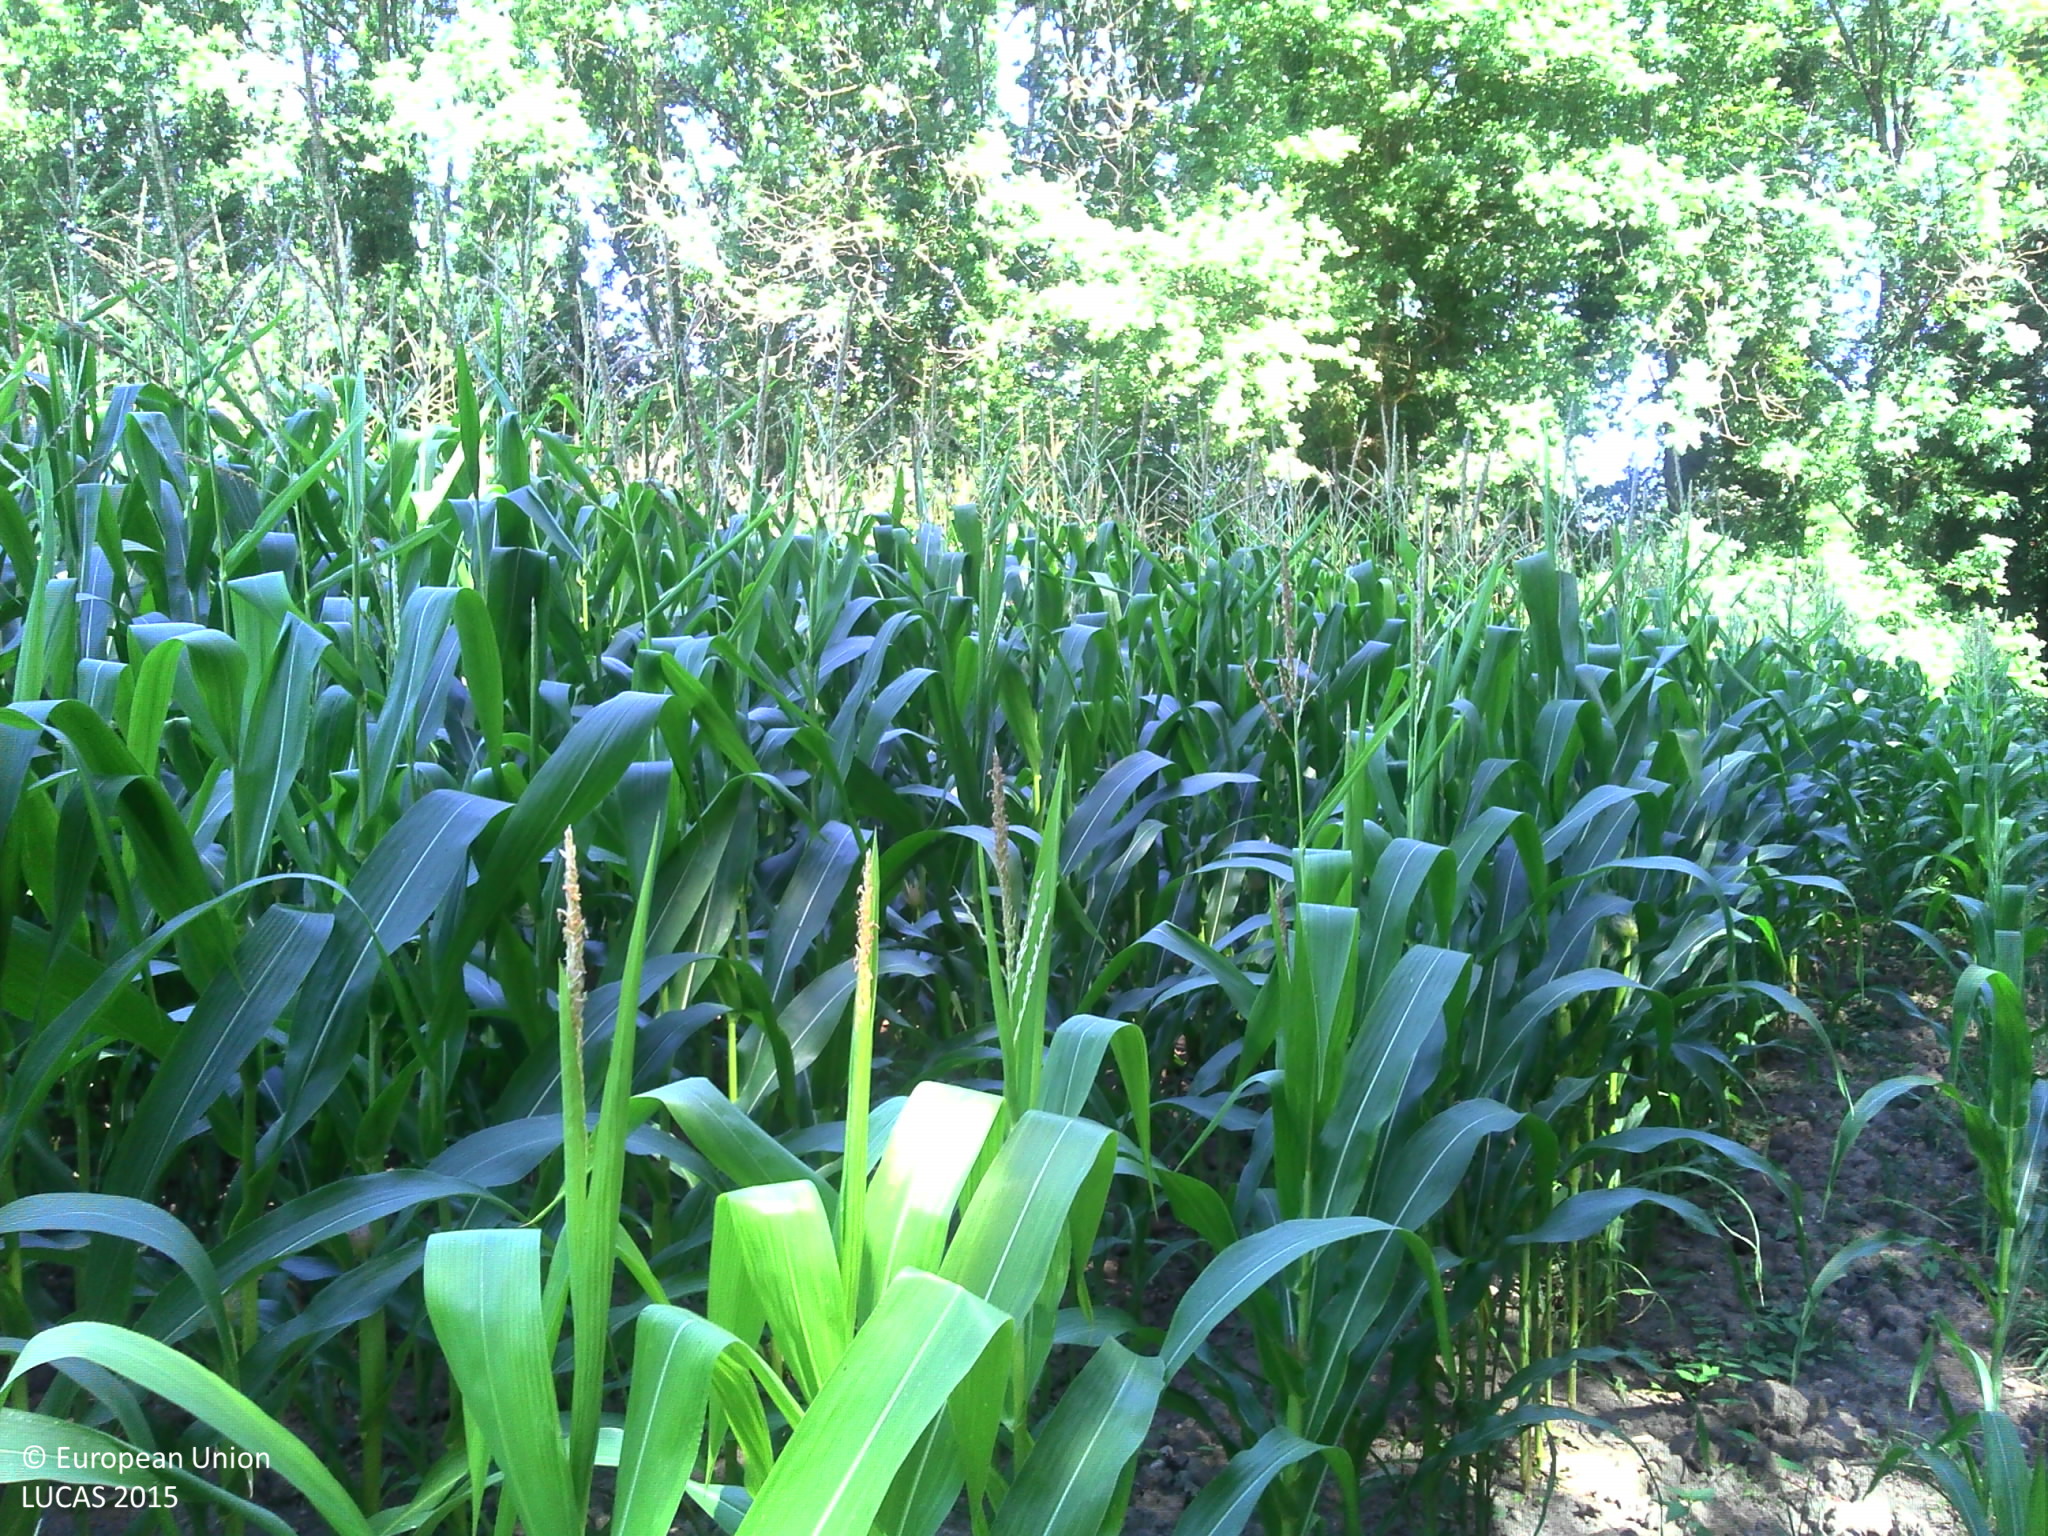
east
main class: Cropland
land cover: Maize
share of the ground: > 75 %
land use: Agriculture (excluding fallow land and kitchen gardens)
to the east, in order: Maize; Broadleaved woodland; Tracks; Lines of trees; Fences; Grassland without tree/shrub cover; Fences; Abandoned hedges; Grassland without tree/shrub cover; Lines of trees; Maize; Tracks
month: July
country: FR
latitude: 45.6410
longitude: 5.4498
